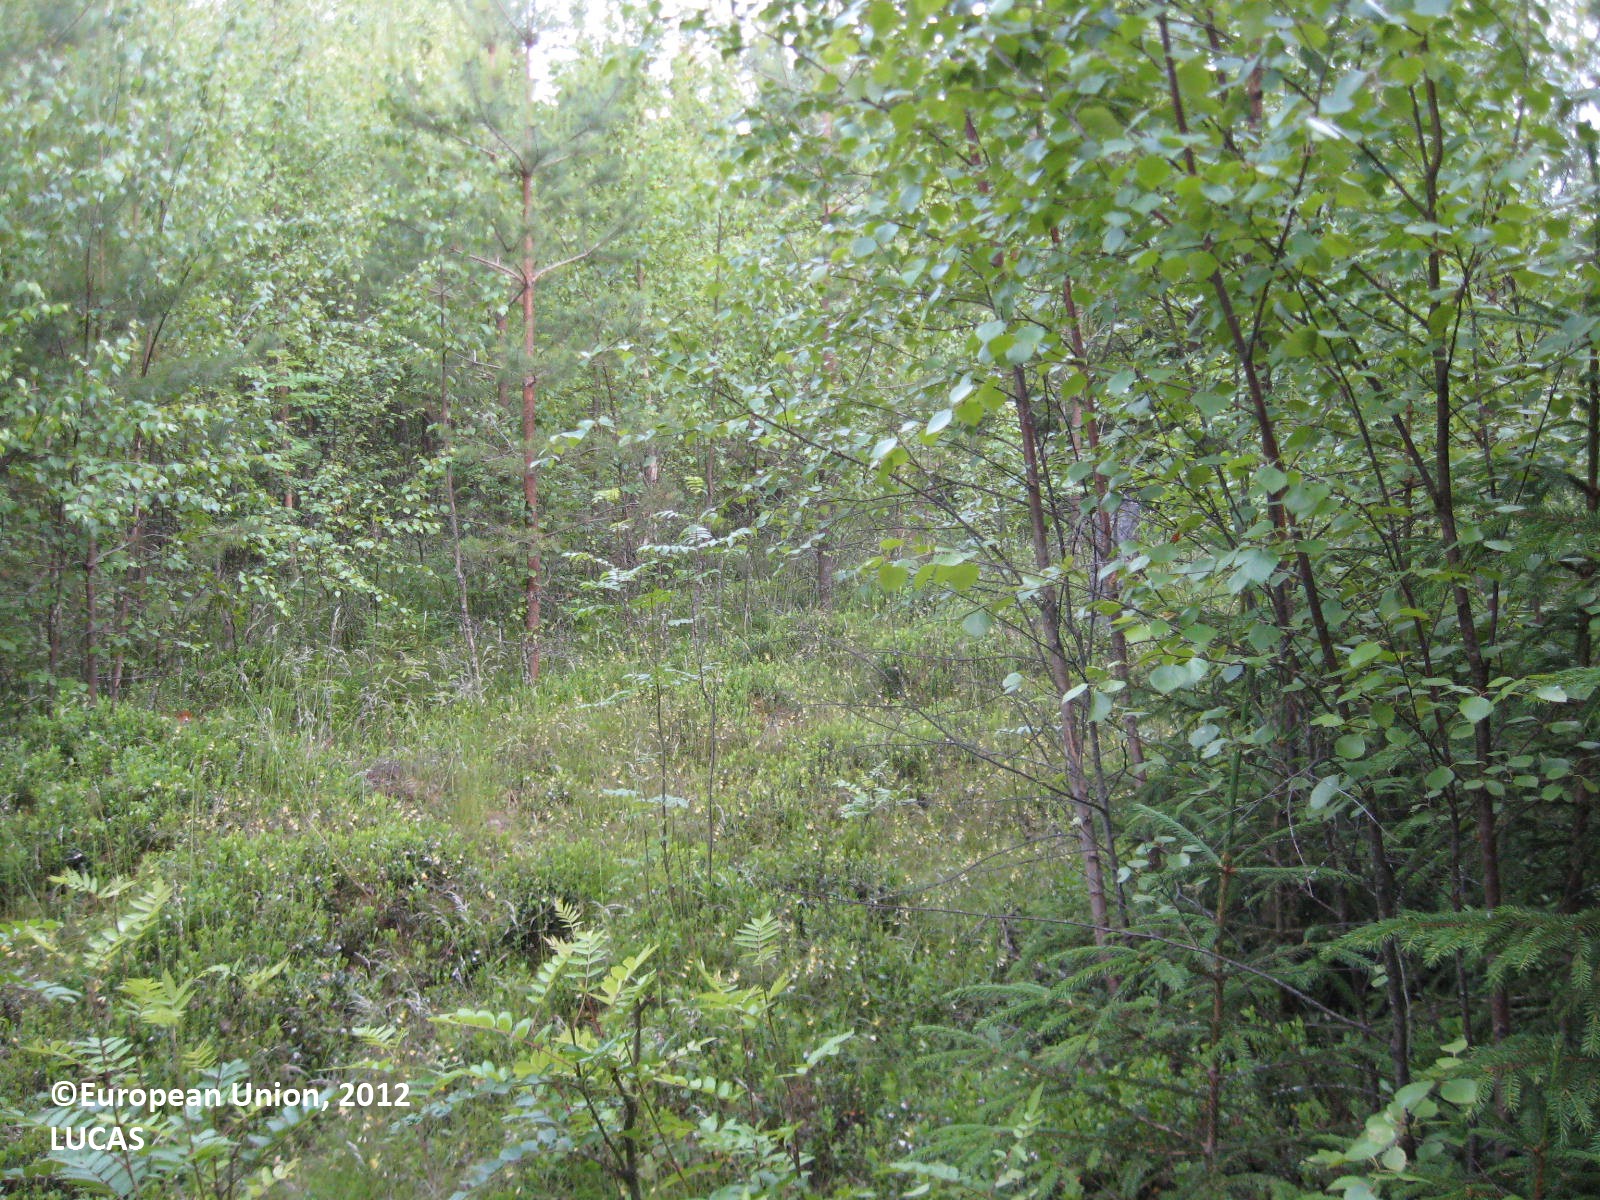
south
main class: Woodland
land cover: Pine dominated mixed woodland
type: boreal forest
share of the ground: > 75 %
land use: Forestry
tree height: > 5 m
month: July
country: FI
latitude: 62.5885
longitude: 22.6544
